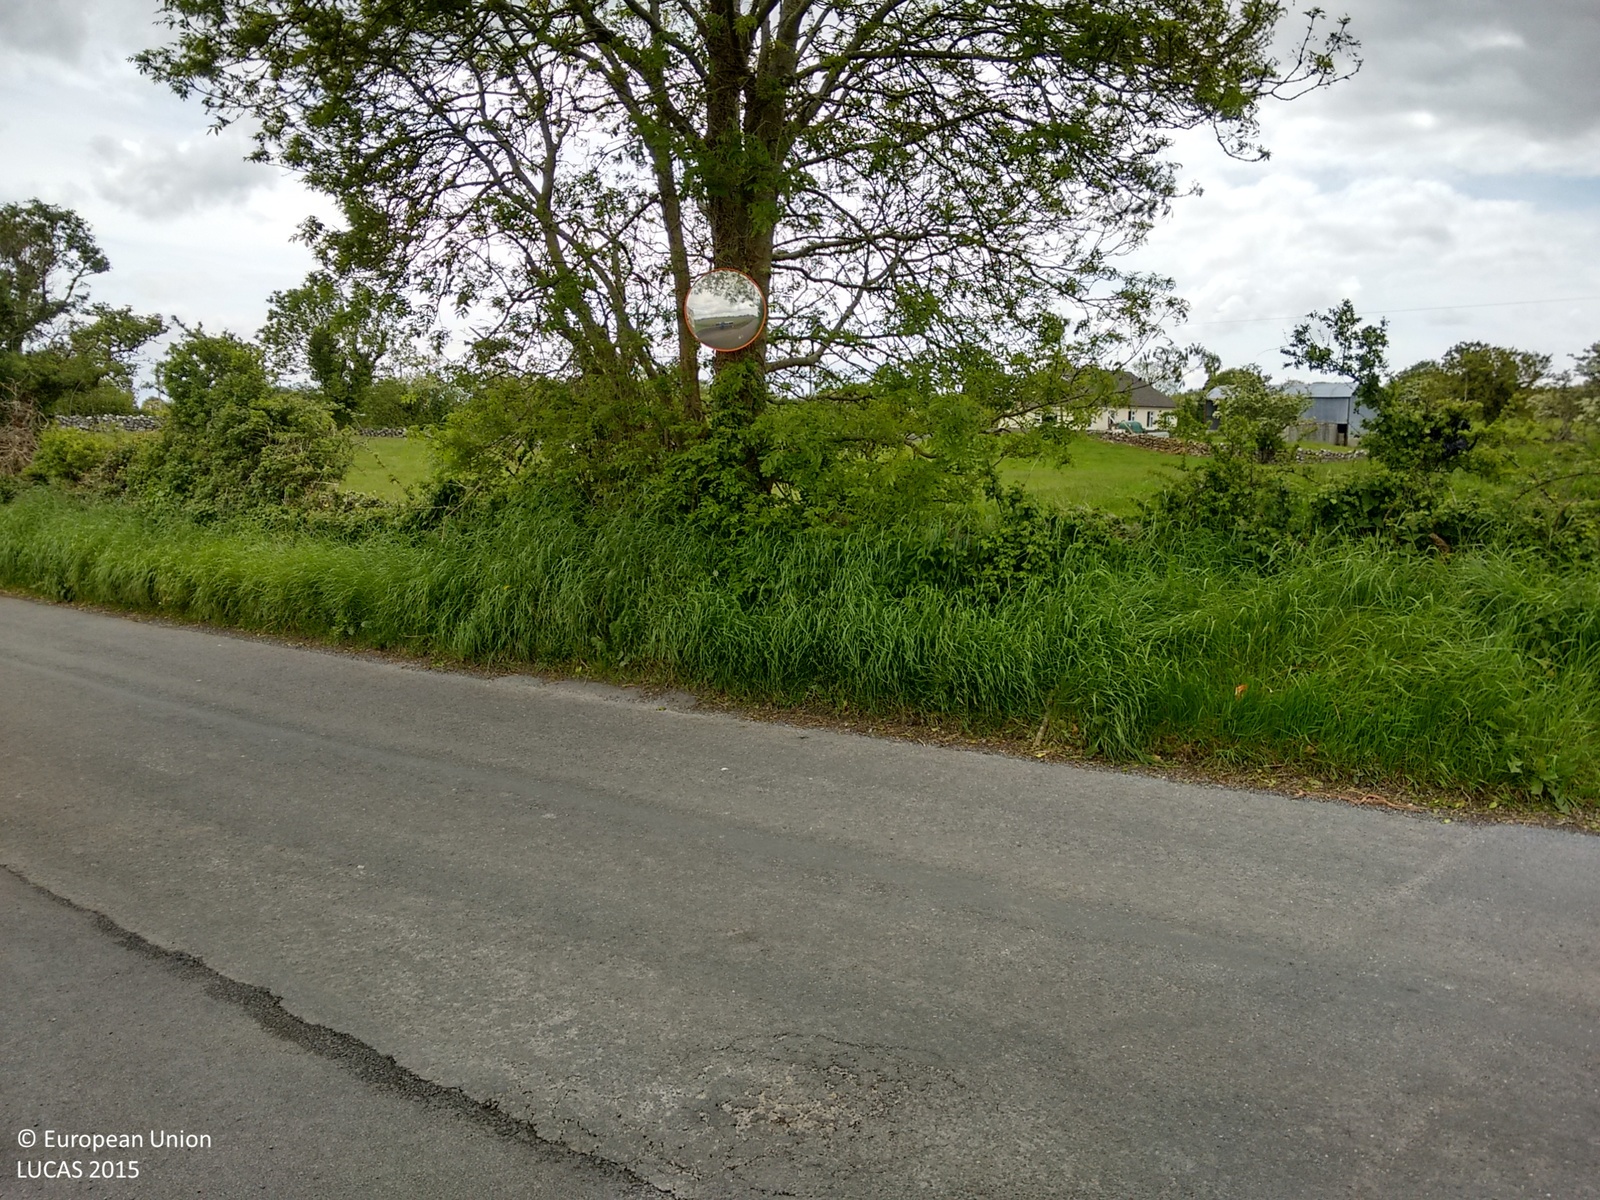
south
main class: Grassland
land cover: Grassland without tree/shrub cover
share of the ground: > 75 %
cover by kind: herbaceous plants 100 %
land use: Agriculture (excluding fallow land and kitchen gardens)
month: June
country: IE
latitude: 53.4594
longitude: -9.0560
